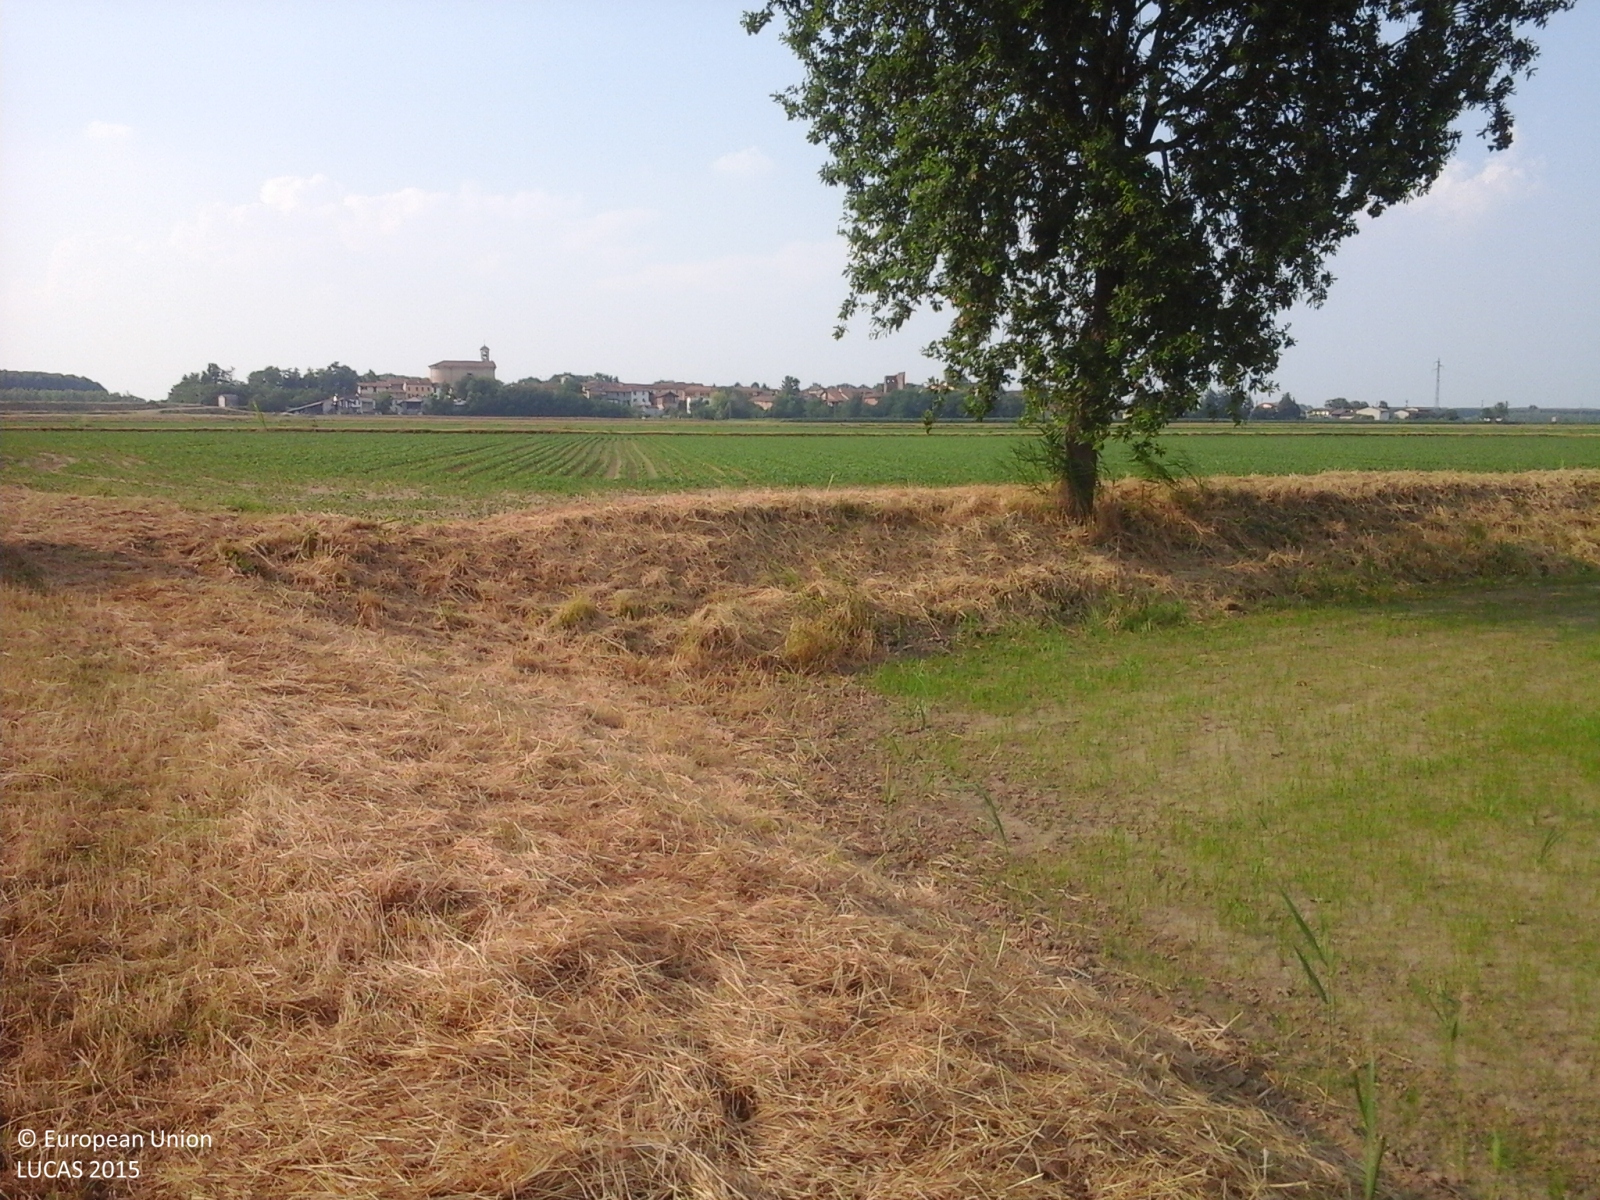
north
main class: Cropland
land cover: Rice
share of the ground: 50 - 75 %
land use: Agriculture (excluding fallow land and kitchen gardens)
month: June
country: IT
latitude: 45.1240
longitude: 9.3782
